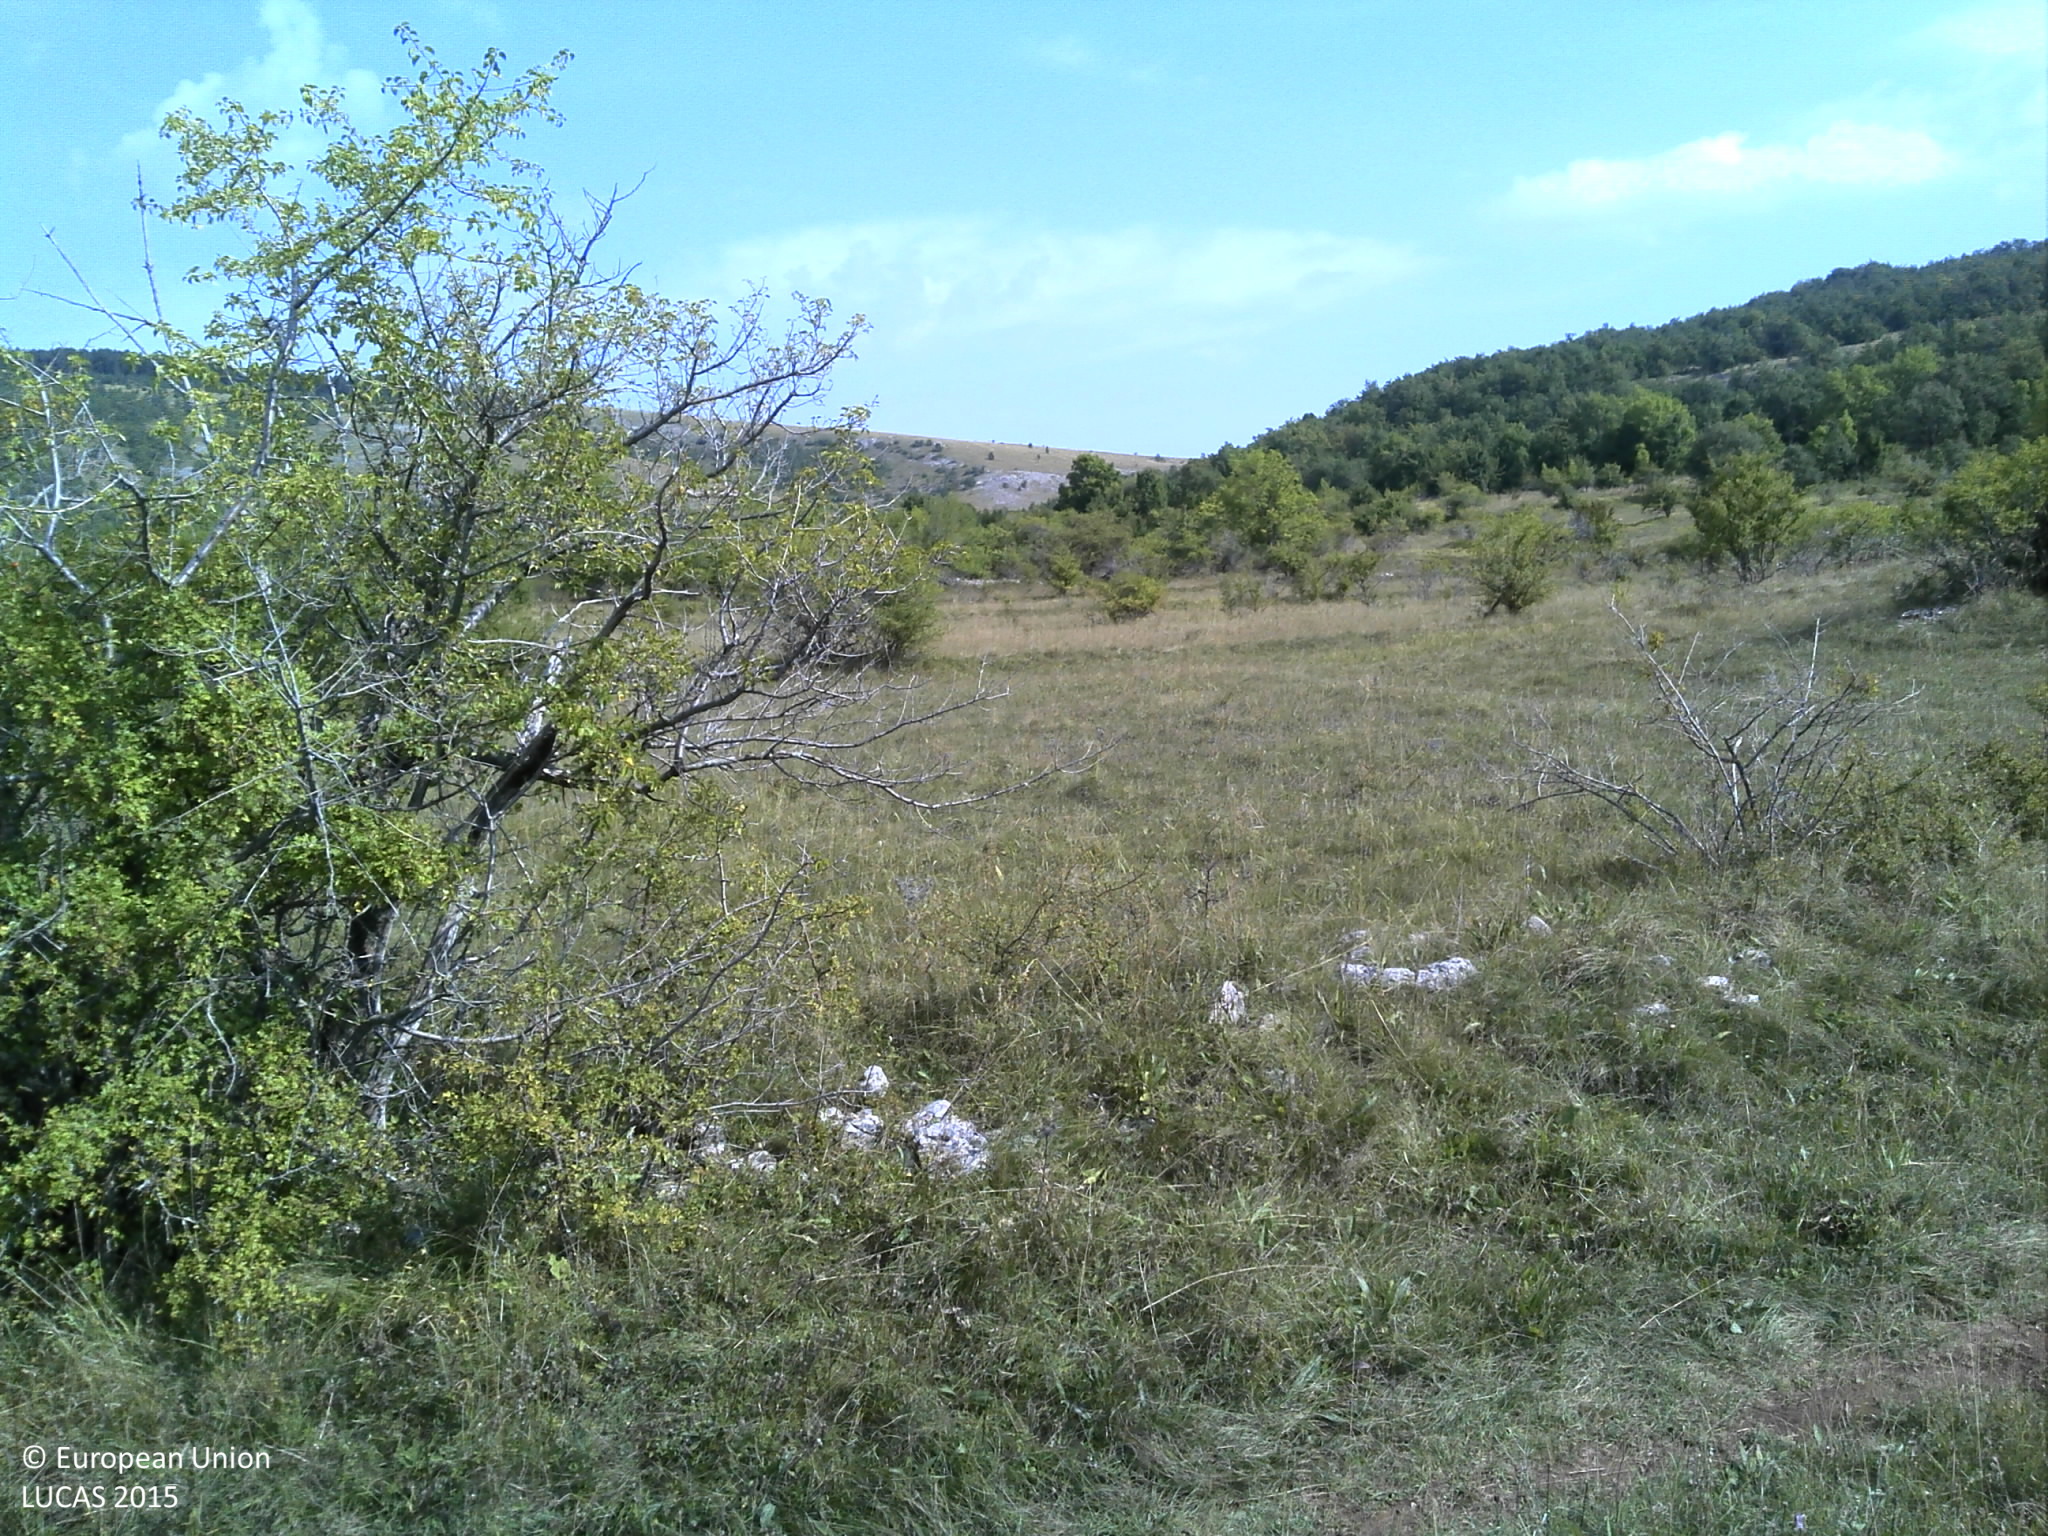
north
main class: Grassland
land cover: Grassland with sparse tree/shrub cover
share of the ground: > 75 %
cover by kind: herbaceous plants 85 %, shrubs 10 %, broadleaved forest trees 5 %
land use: Semi-natural and natural areas not in use
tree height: < 5 m
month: September
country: HR
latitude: 44.3604
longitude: 15.9532
